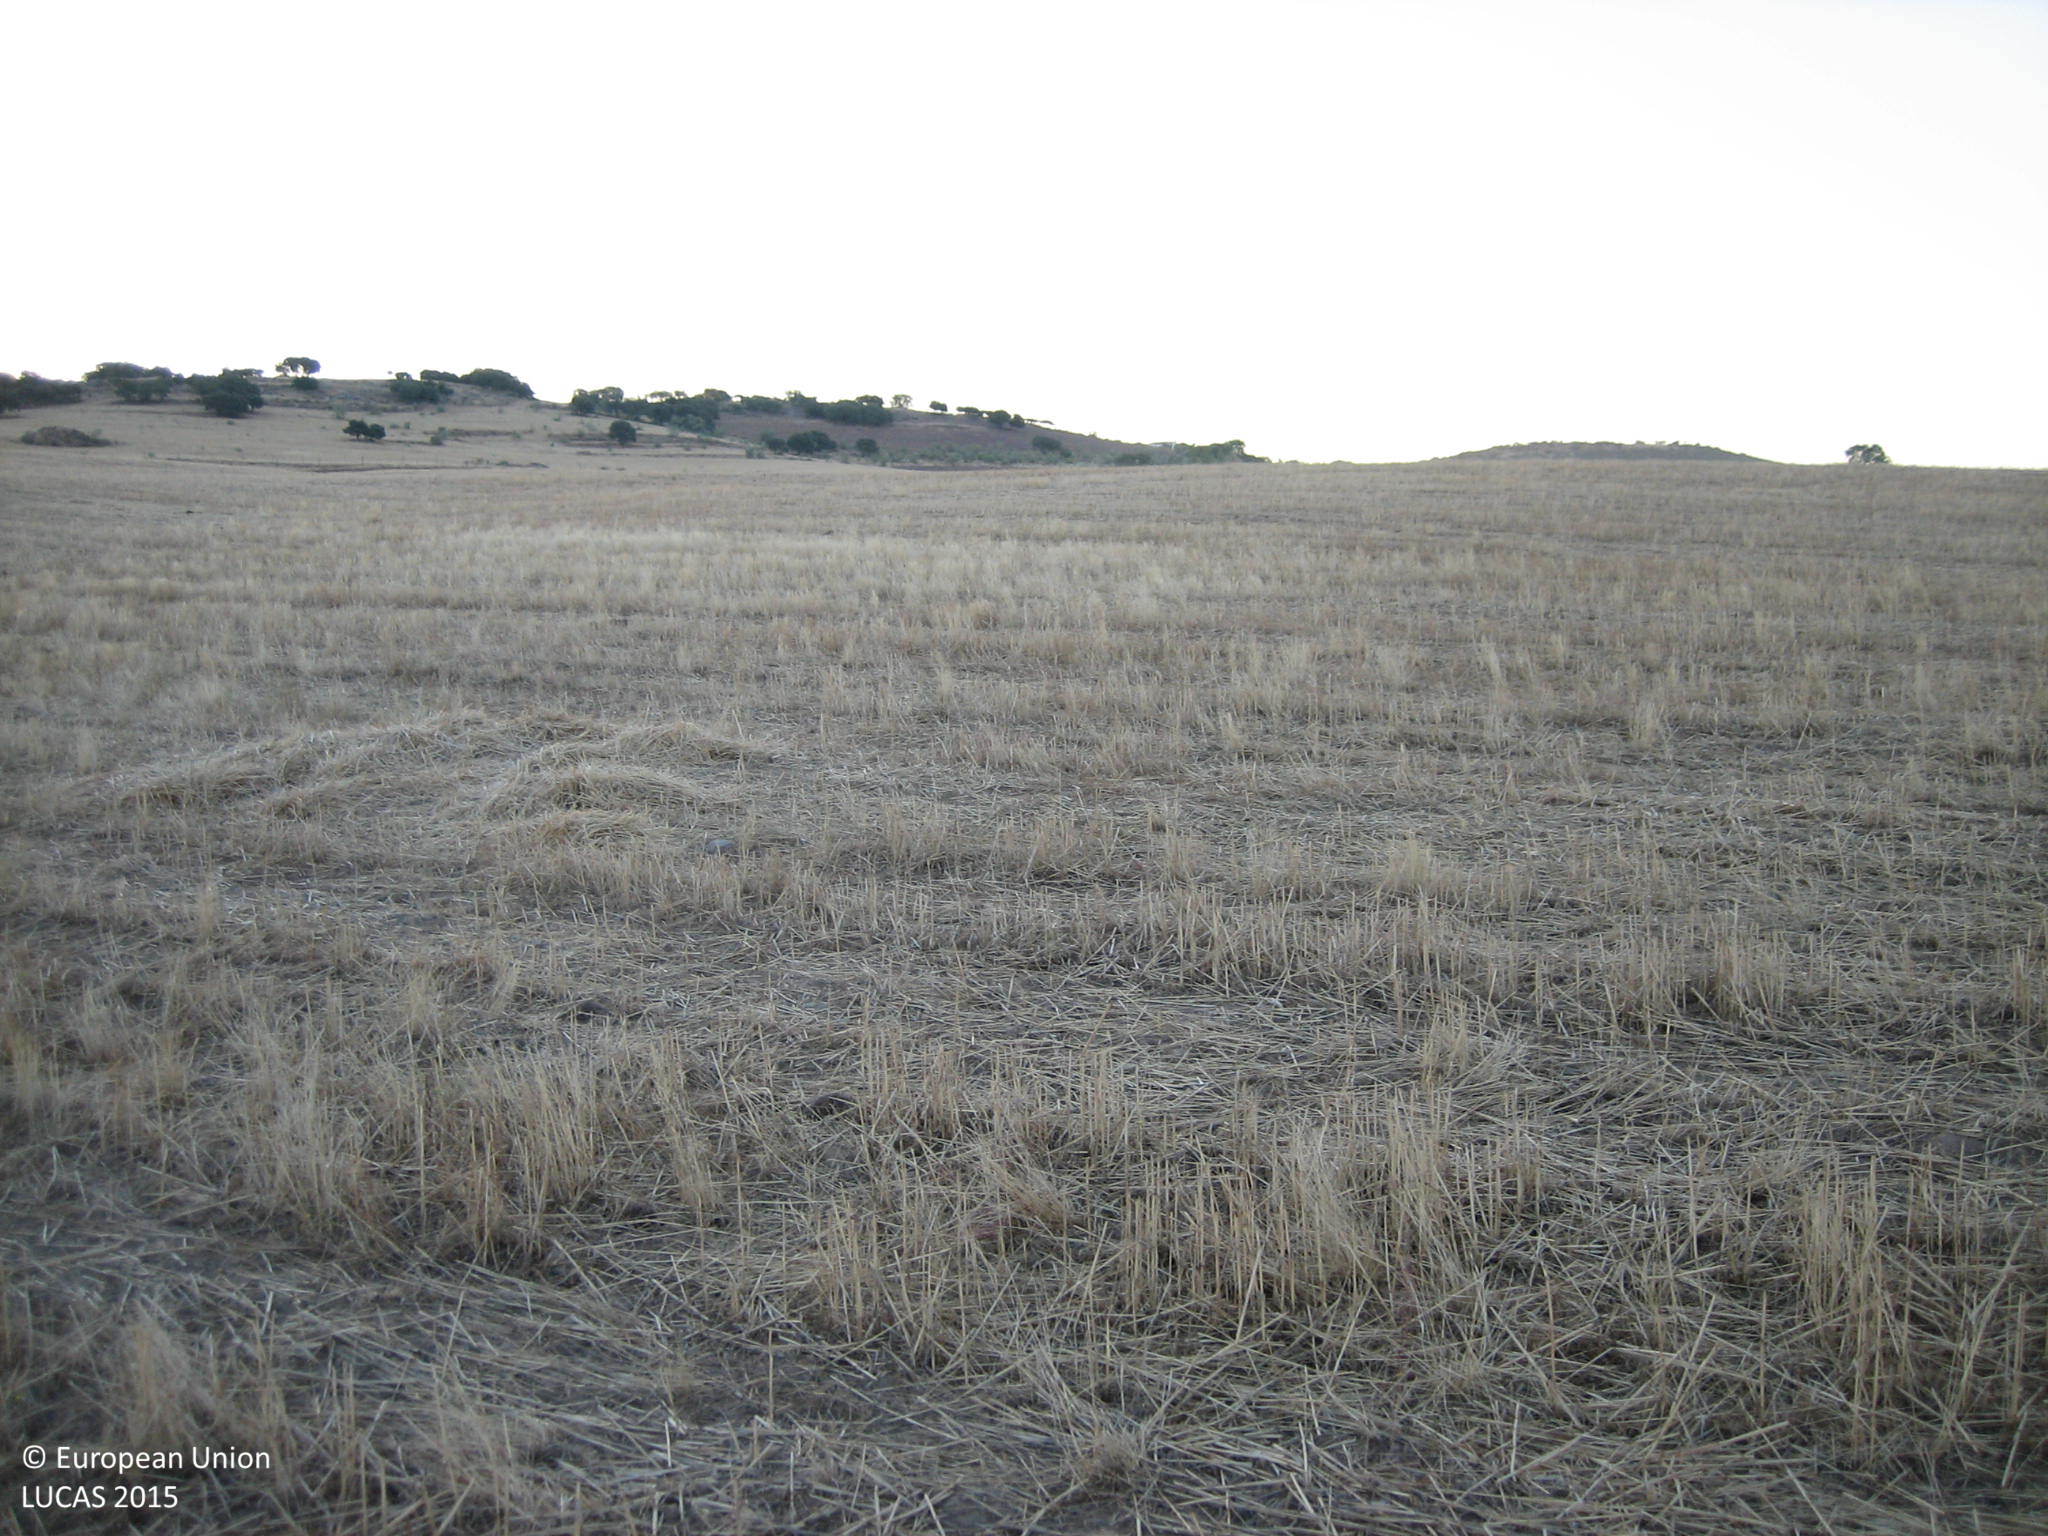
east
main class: Cropland
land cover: Common wheat
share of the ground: < 10 %
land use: Agriculture (excluding fallow land and kitchen gardens)
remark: Harvested field
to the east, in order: Common wheat; Rivers and streams; Common wheat
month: July
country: ES
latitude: 38.2649
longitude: -6.0997
